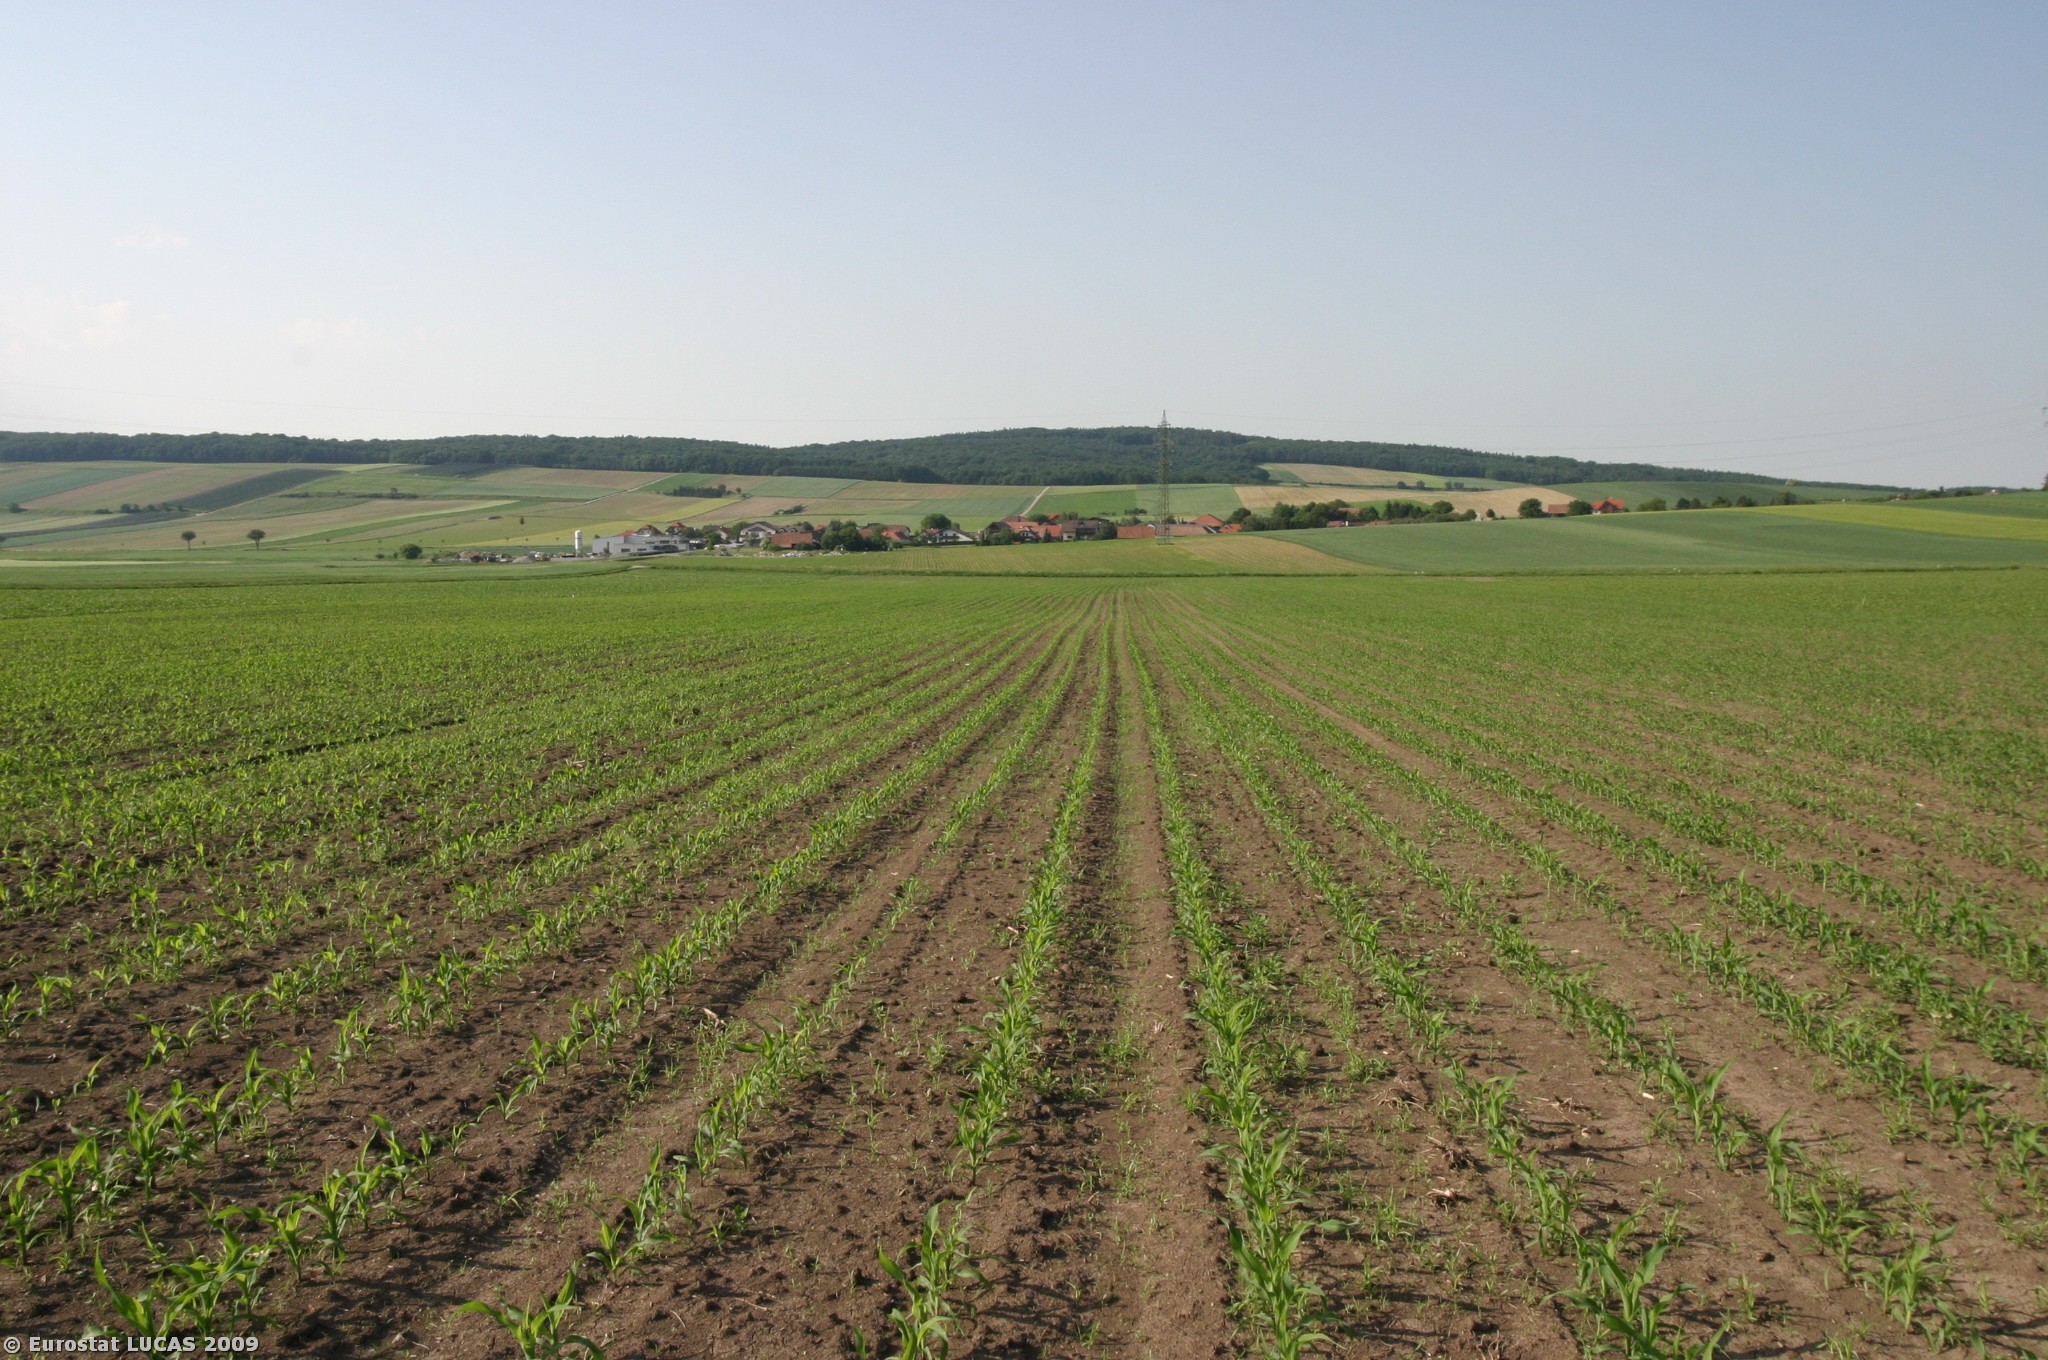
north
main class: Cropland
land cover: Maize
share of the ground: 10 - 25 %
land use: Agriculture (excluding fallow land and kitchen gardens)
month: May
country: AT
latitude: 48.2243
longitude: 15.9669
